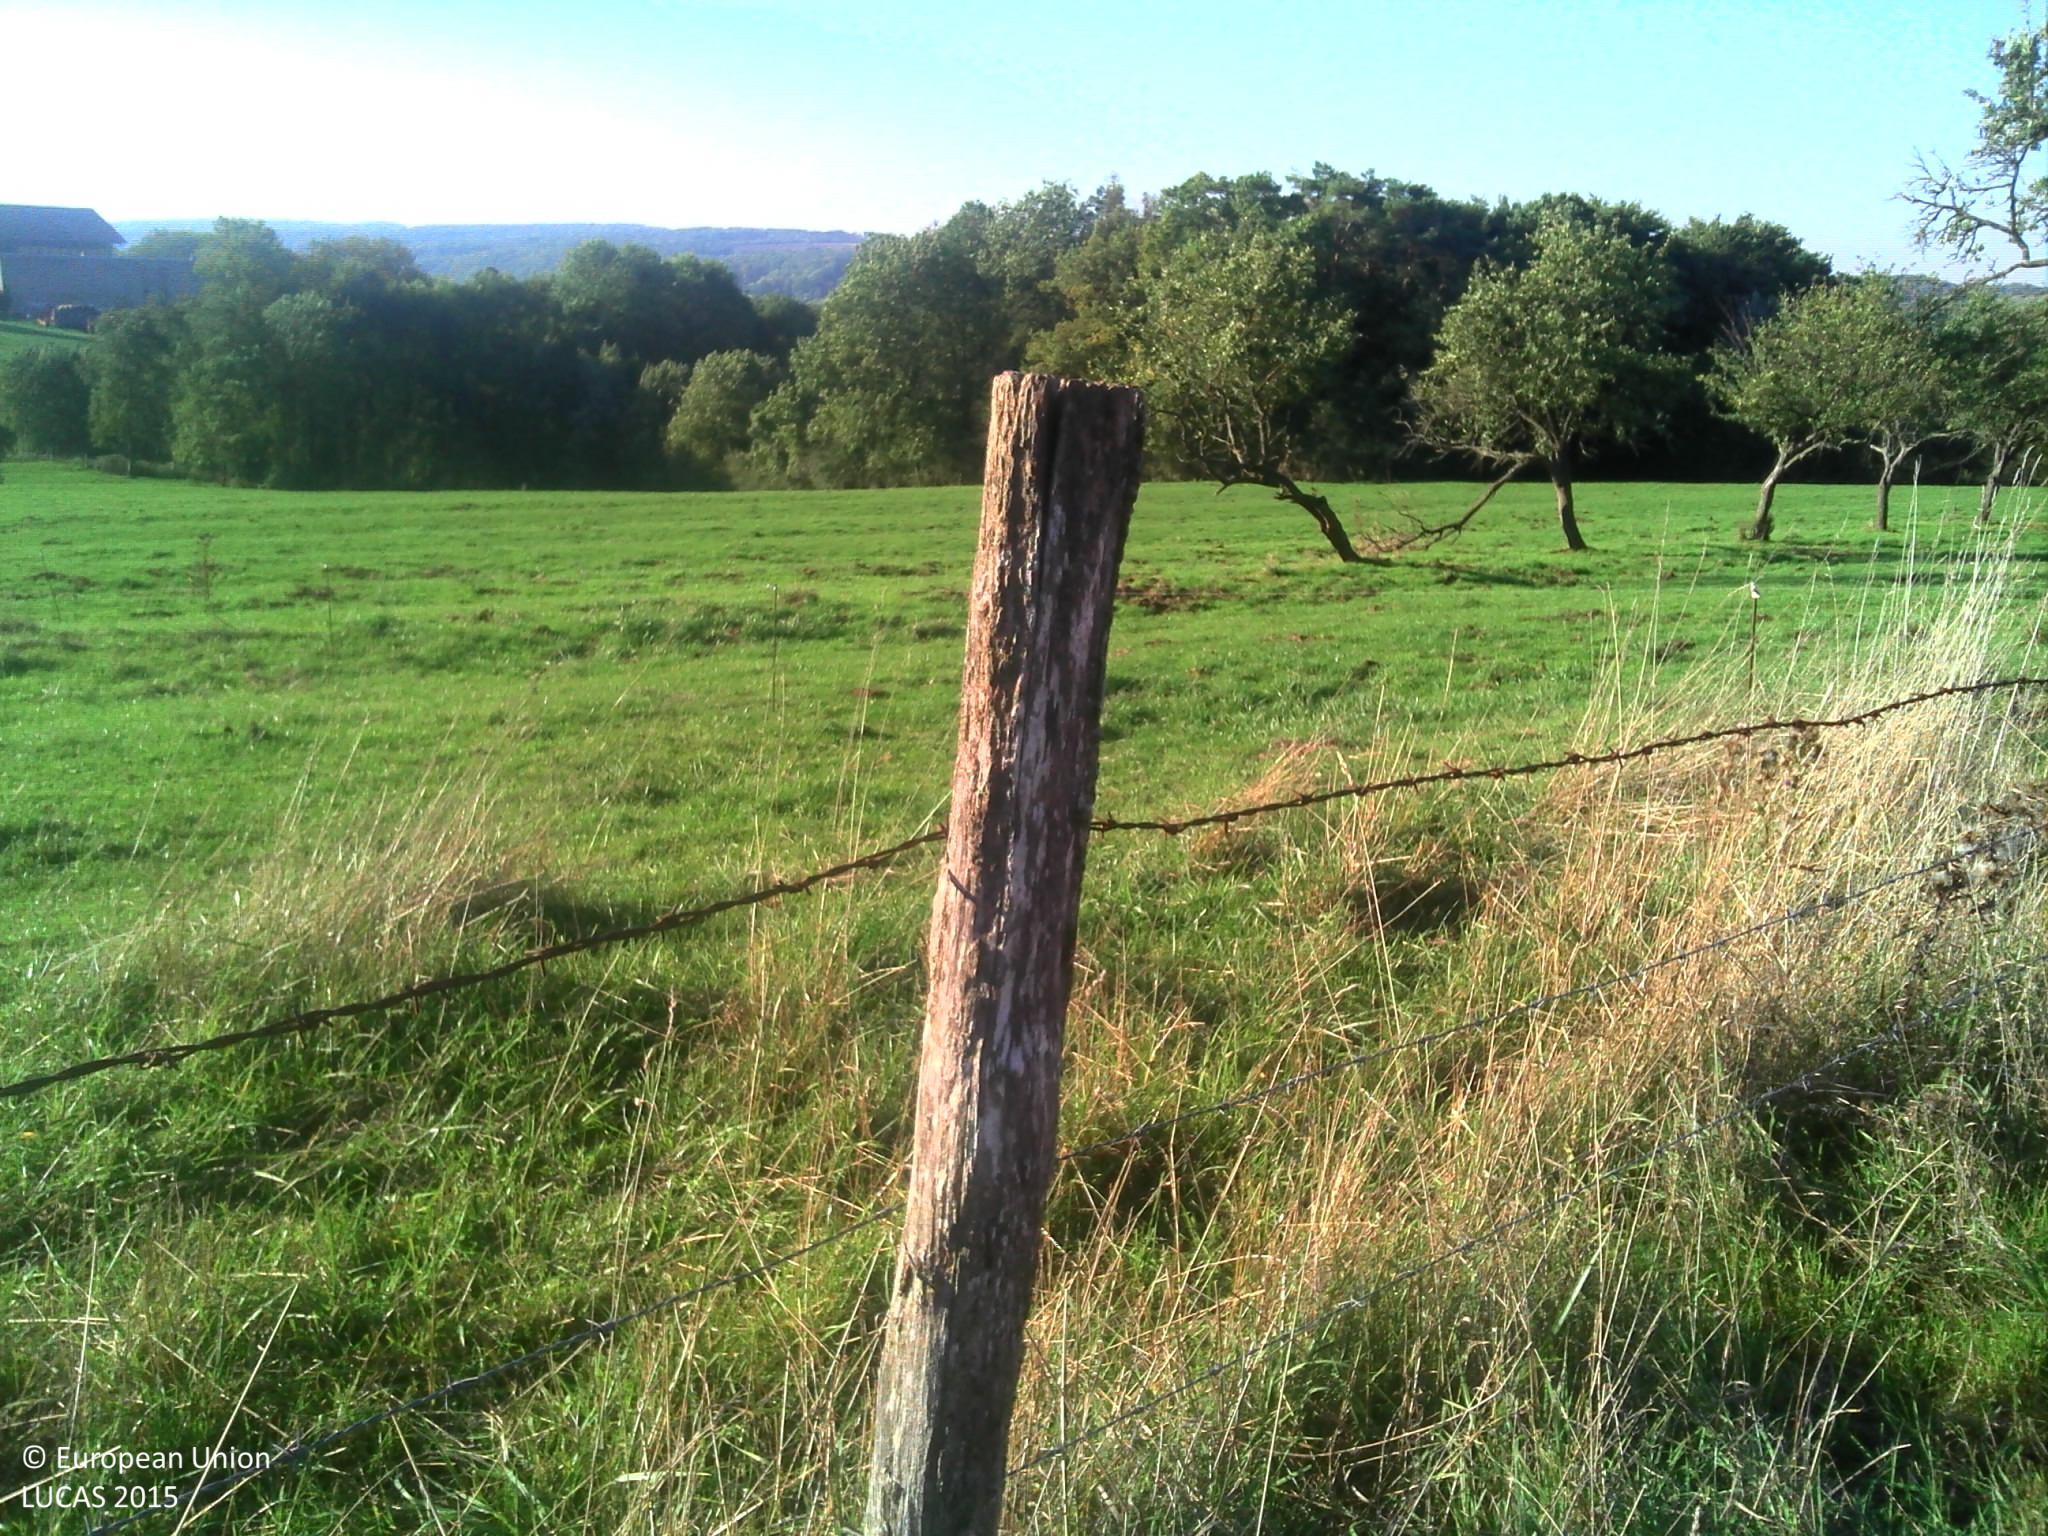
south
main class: Cropland
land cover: Common wheat
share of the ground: < 10 %
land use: Agriculture (excluding fallow land and kitchen gardens)
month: October
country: FR
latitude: 48.5389
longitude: 6.2756
